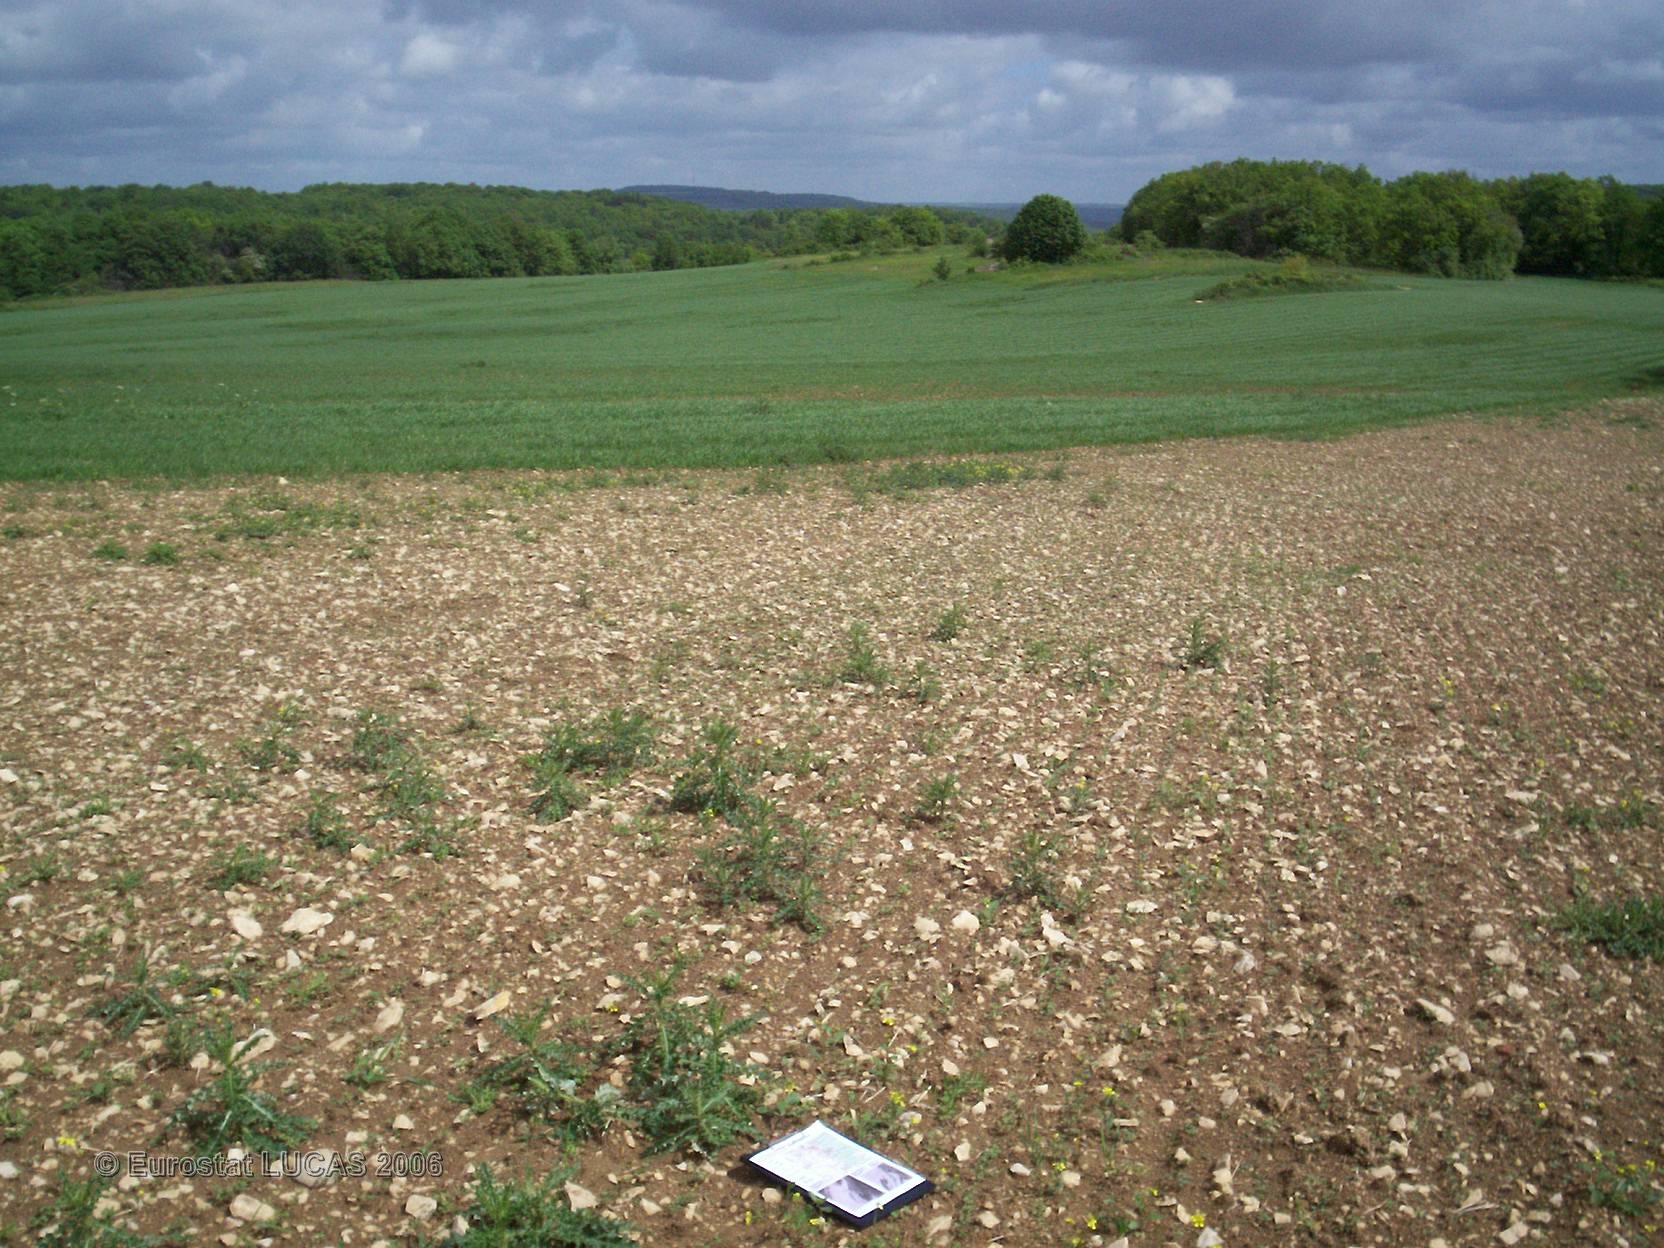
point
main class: Cropland
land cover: Clovers
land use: Fallow land
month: May
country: FR
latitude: 47.0843
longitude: 4.6657
